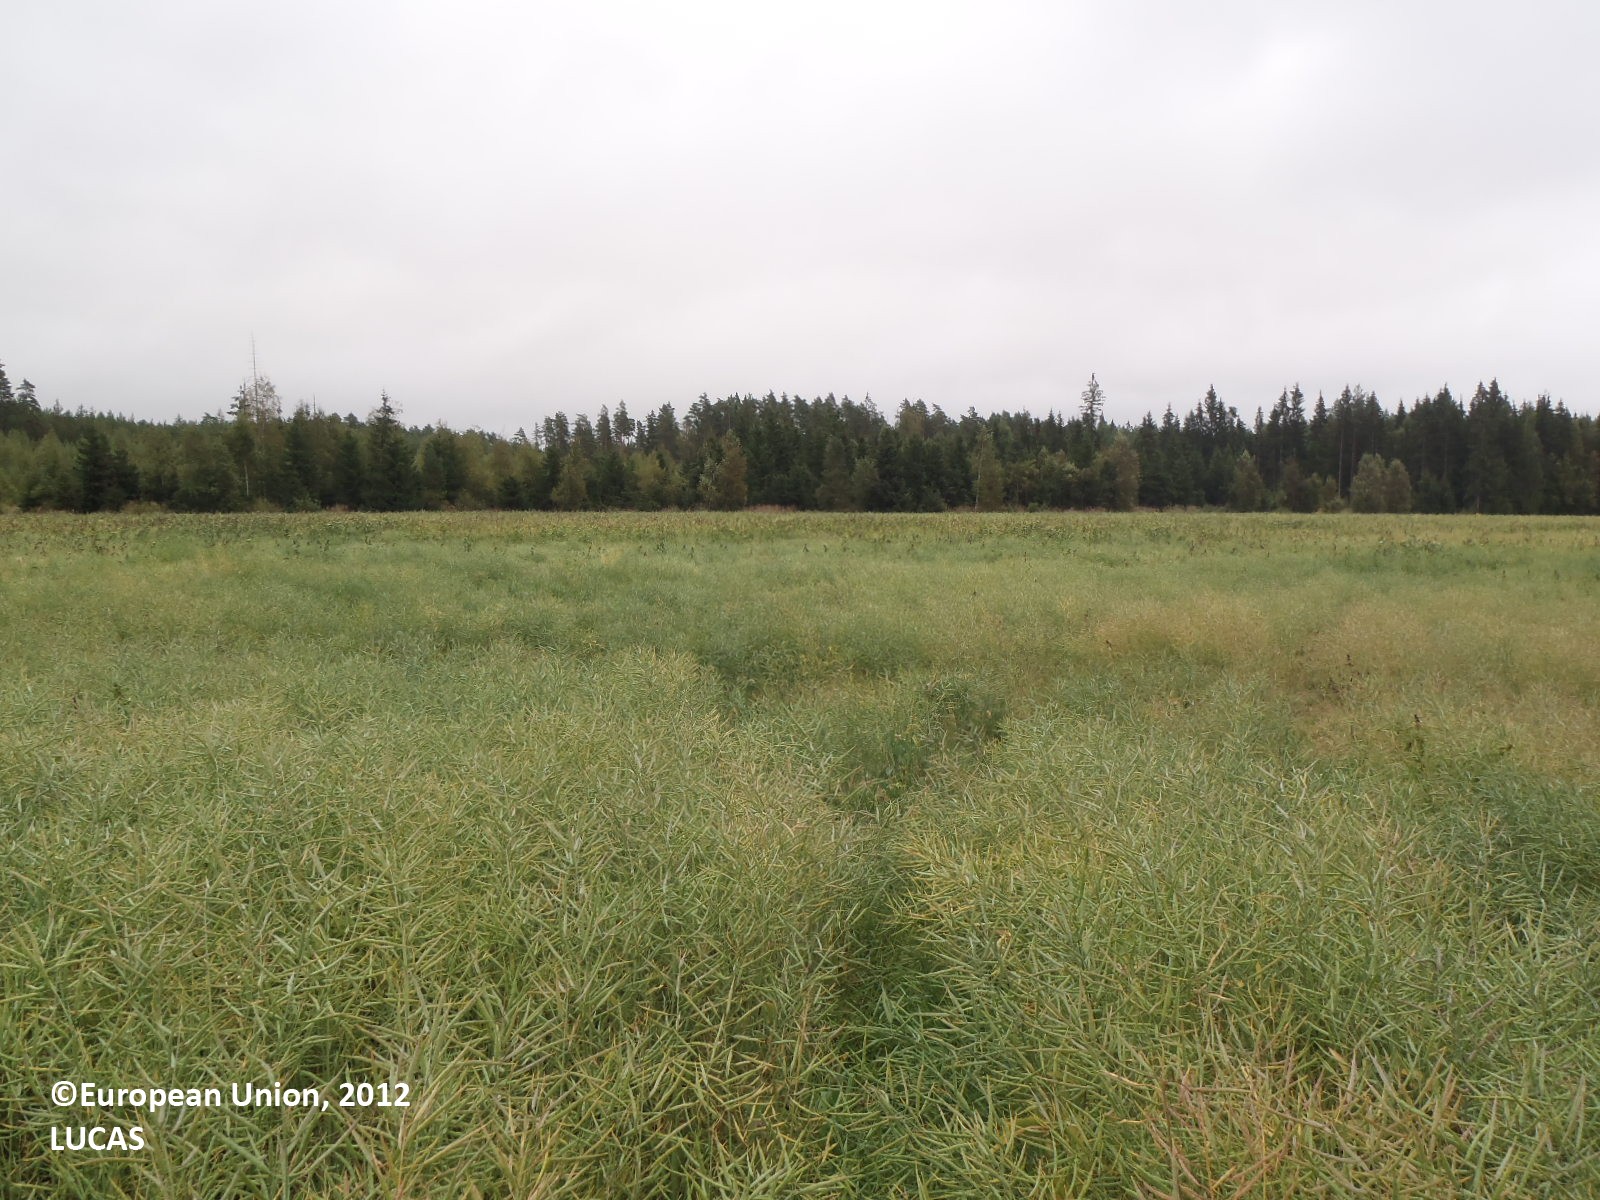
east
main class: Cropland
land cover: Rape and turnip rape
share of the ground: > 75 %
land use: Agriculture (excluding fallow land and kitchen gardens)
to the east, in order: Rape and turnip rape; Grass margins; Ditches and canals; Spruce dominated mixed woodland; Ditches and canals; Spruce dominated mixed woodland; Pine dominated mixed woodland; Broadleaved woodland
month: August
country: FI
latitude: 60.6501
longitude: 22.2282
